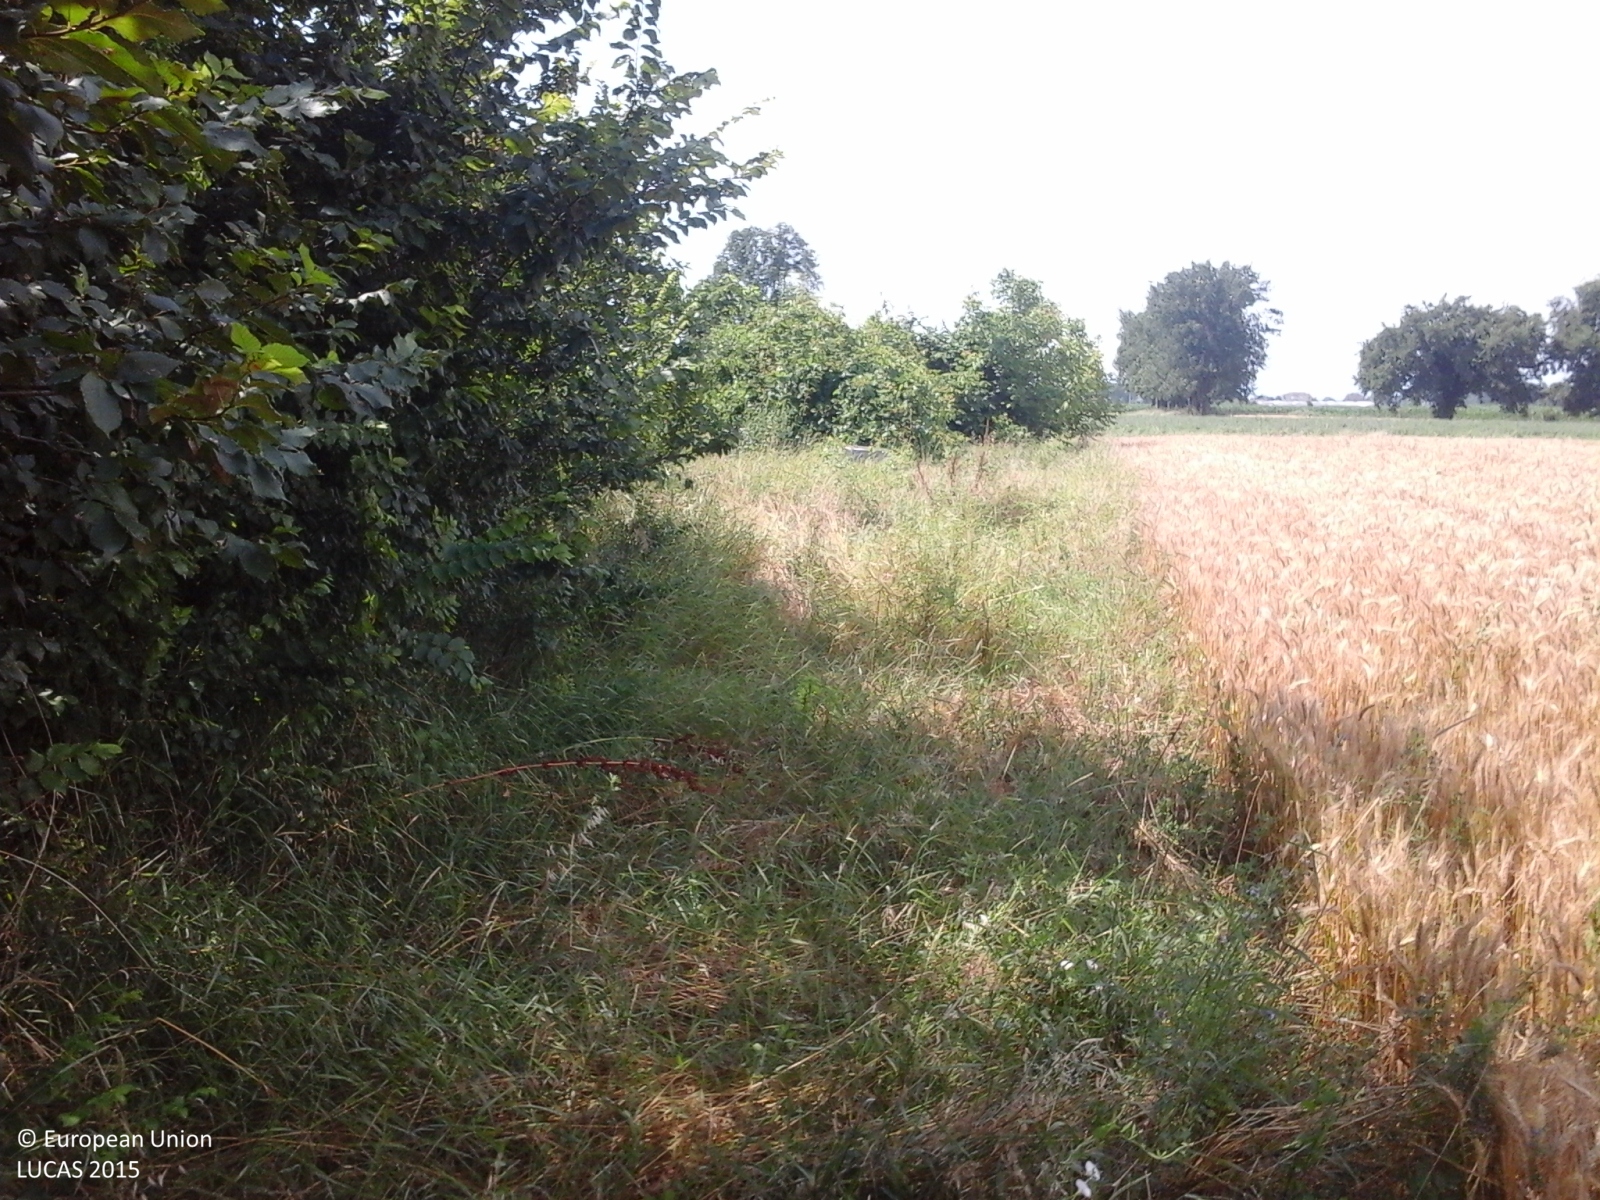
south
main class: Cropland
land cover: Common wheat
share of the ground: > 75 %
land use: Agriculture (excluding fallow land and kitchen gardens)
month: June
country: IT
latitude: 44.6697
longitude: 11.0699
